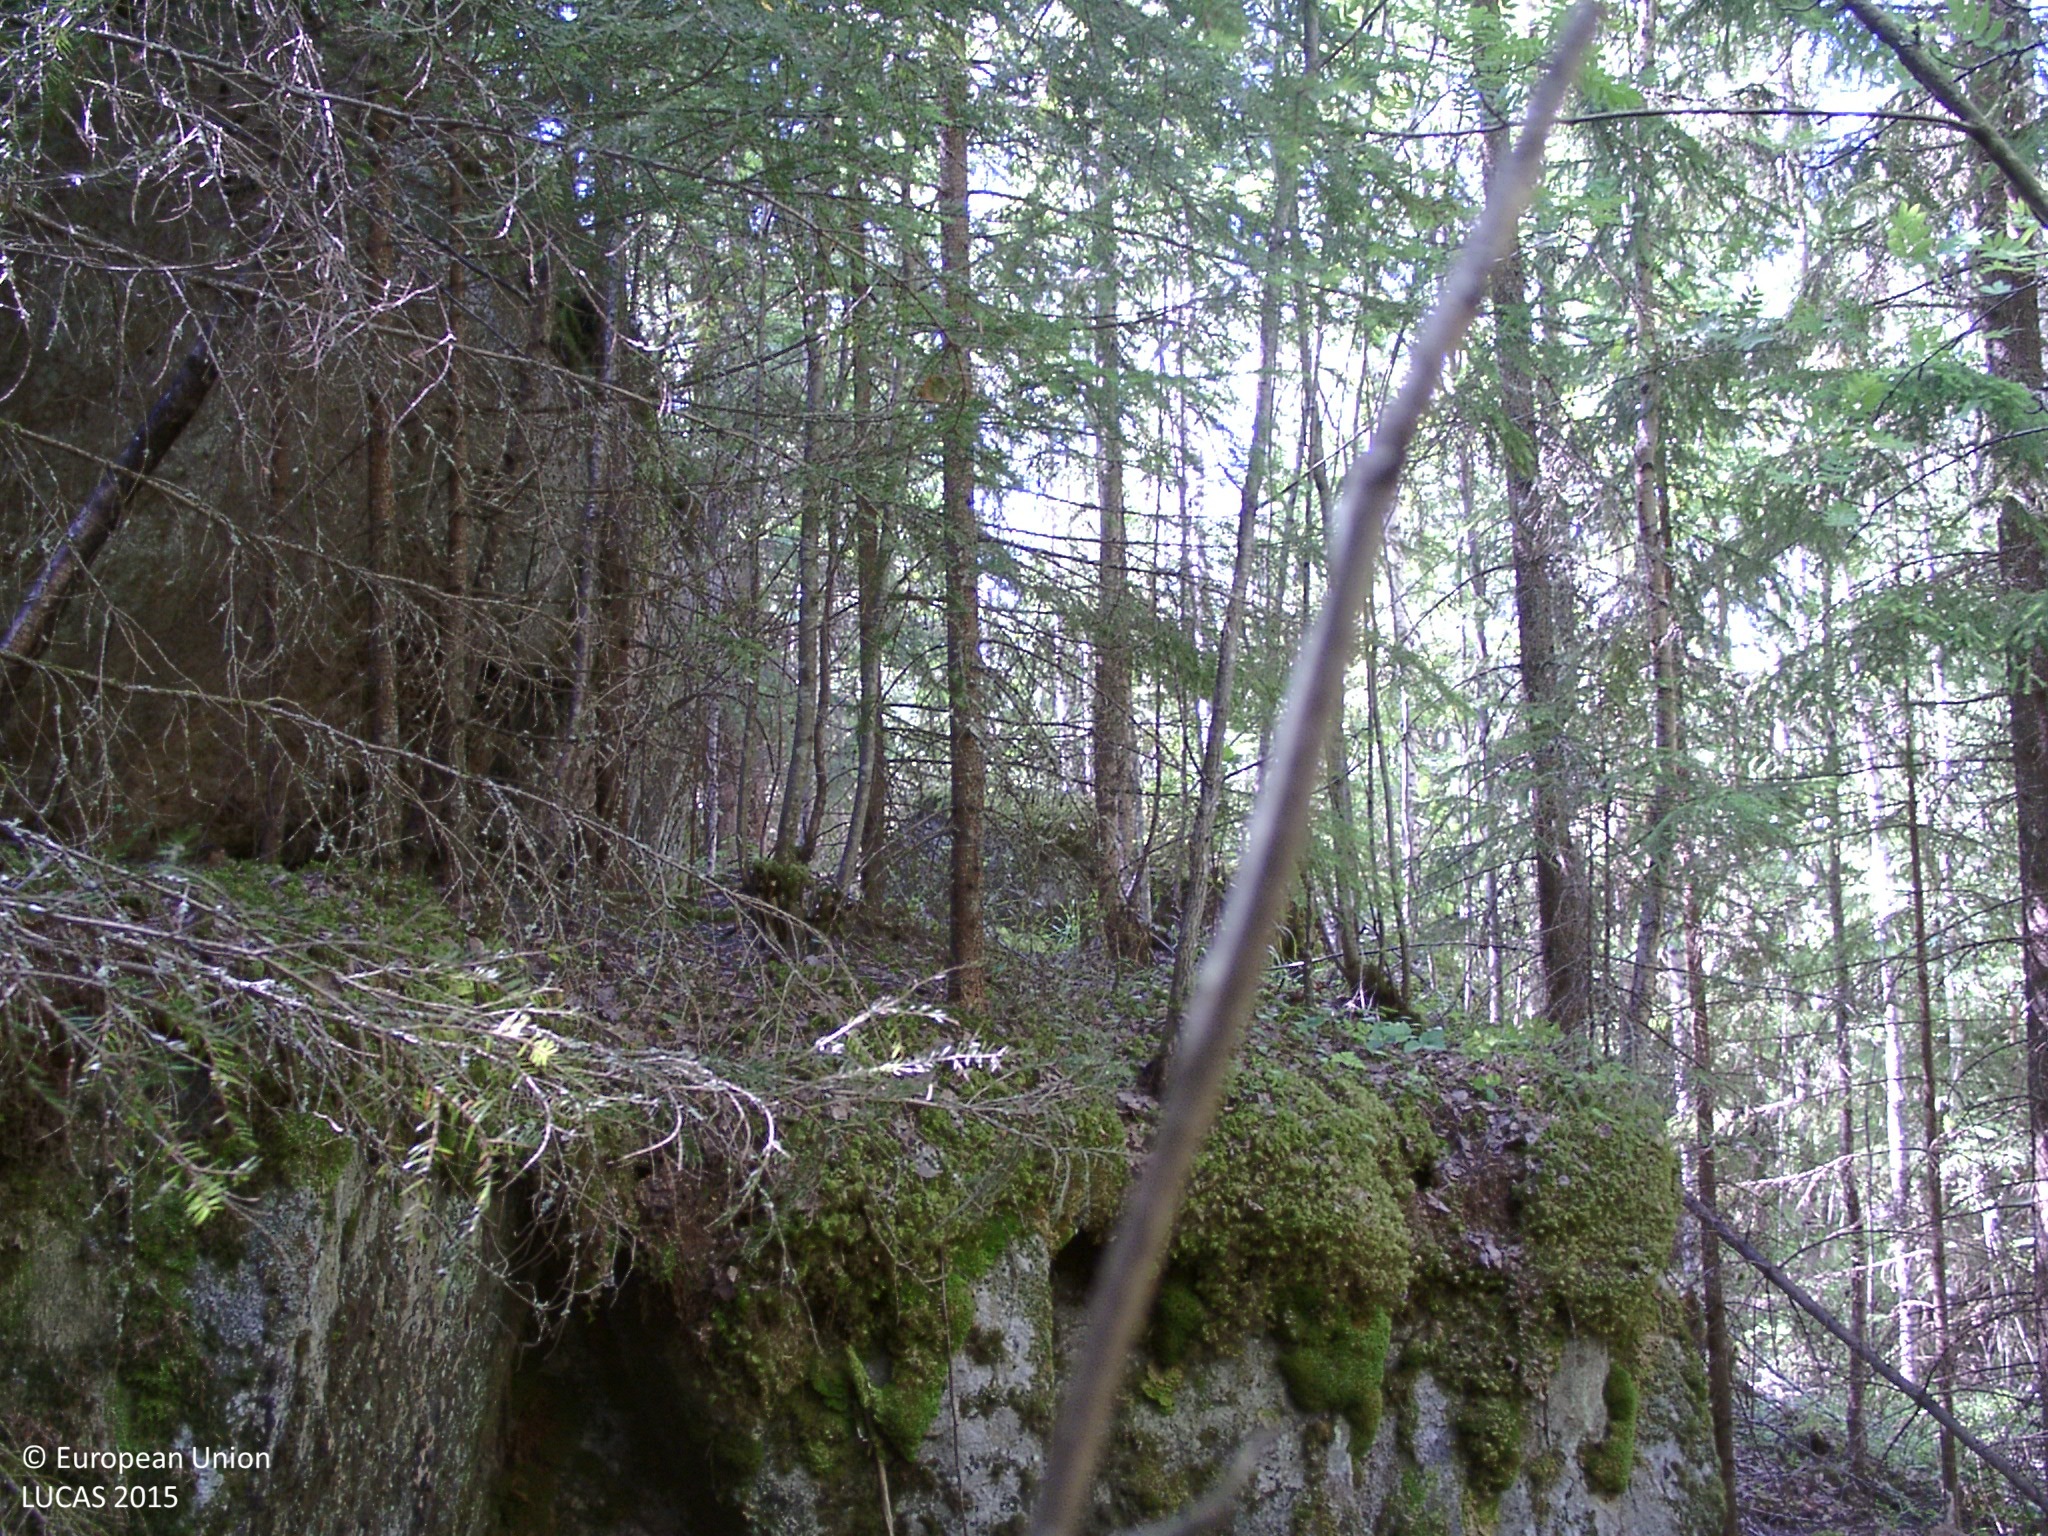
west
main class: Woodland
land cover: Spruce dominated mixed woodland
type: boreal forest
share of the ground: > 75 %
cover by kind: coniferous forest trees 50 %, broadleaved forest trees 35 %, unconsolidated bare surface 10 %, herbaceous plants 5 %
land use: Forestry
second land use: Amenities, museums, leisure
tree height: > 5 m
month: July
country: FI
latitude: 61.9283
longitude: 25.5286
